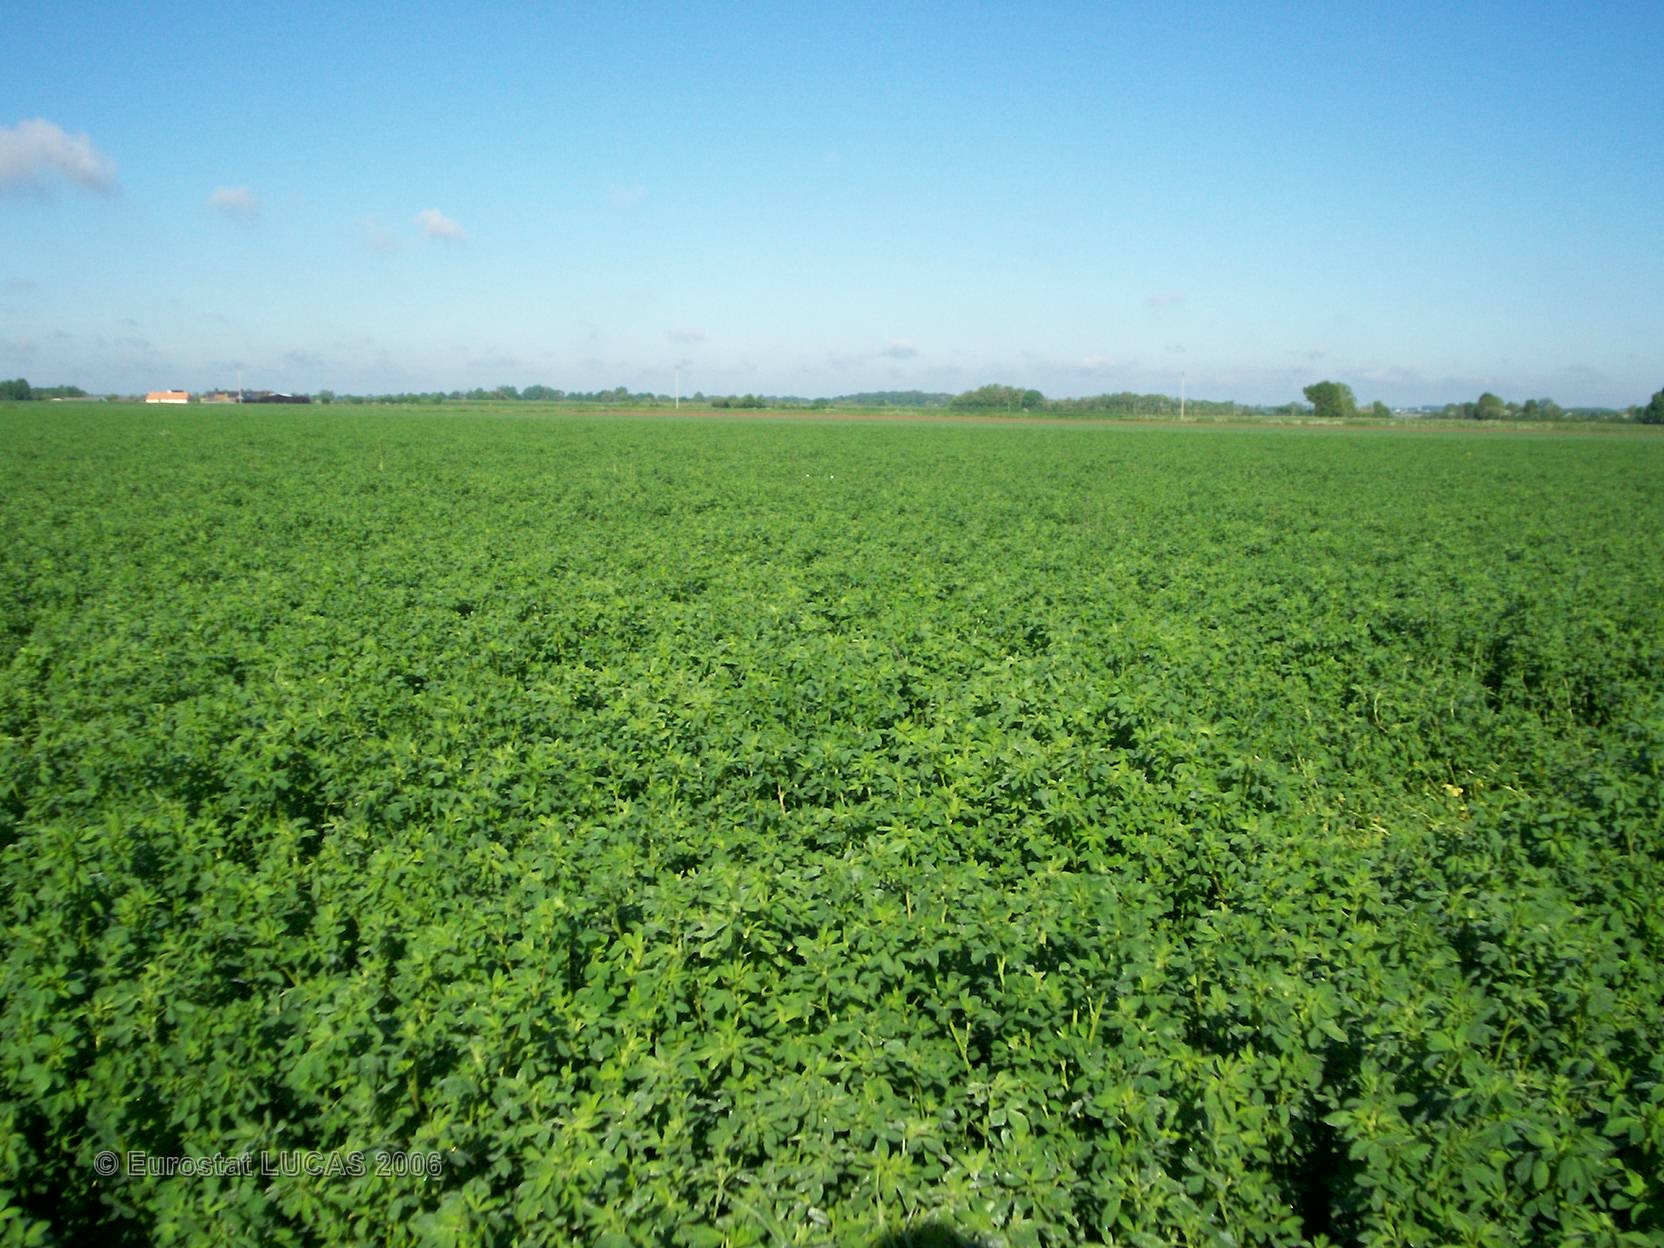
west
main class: Cropland
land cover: Lucerne
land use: Agriculture (excluding fallow land and kitchen gardens)
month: May
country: FR
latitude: 47.2074
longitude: -0.3657
